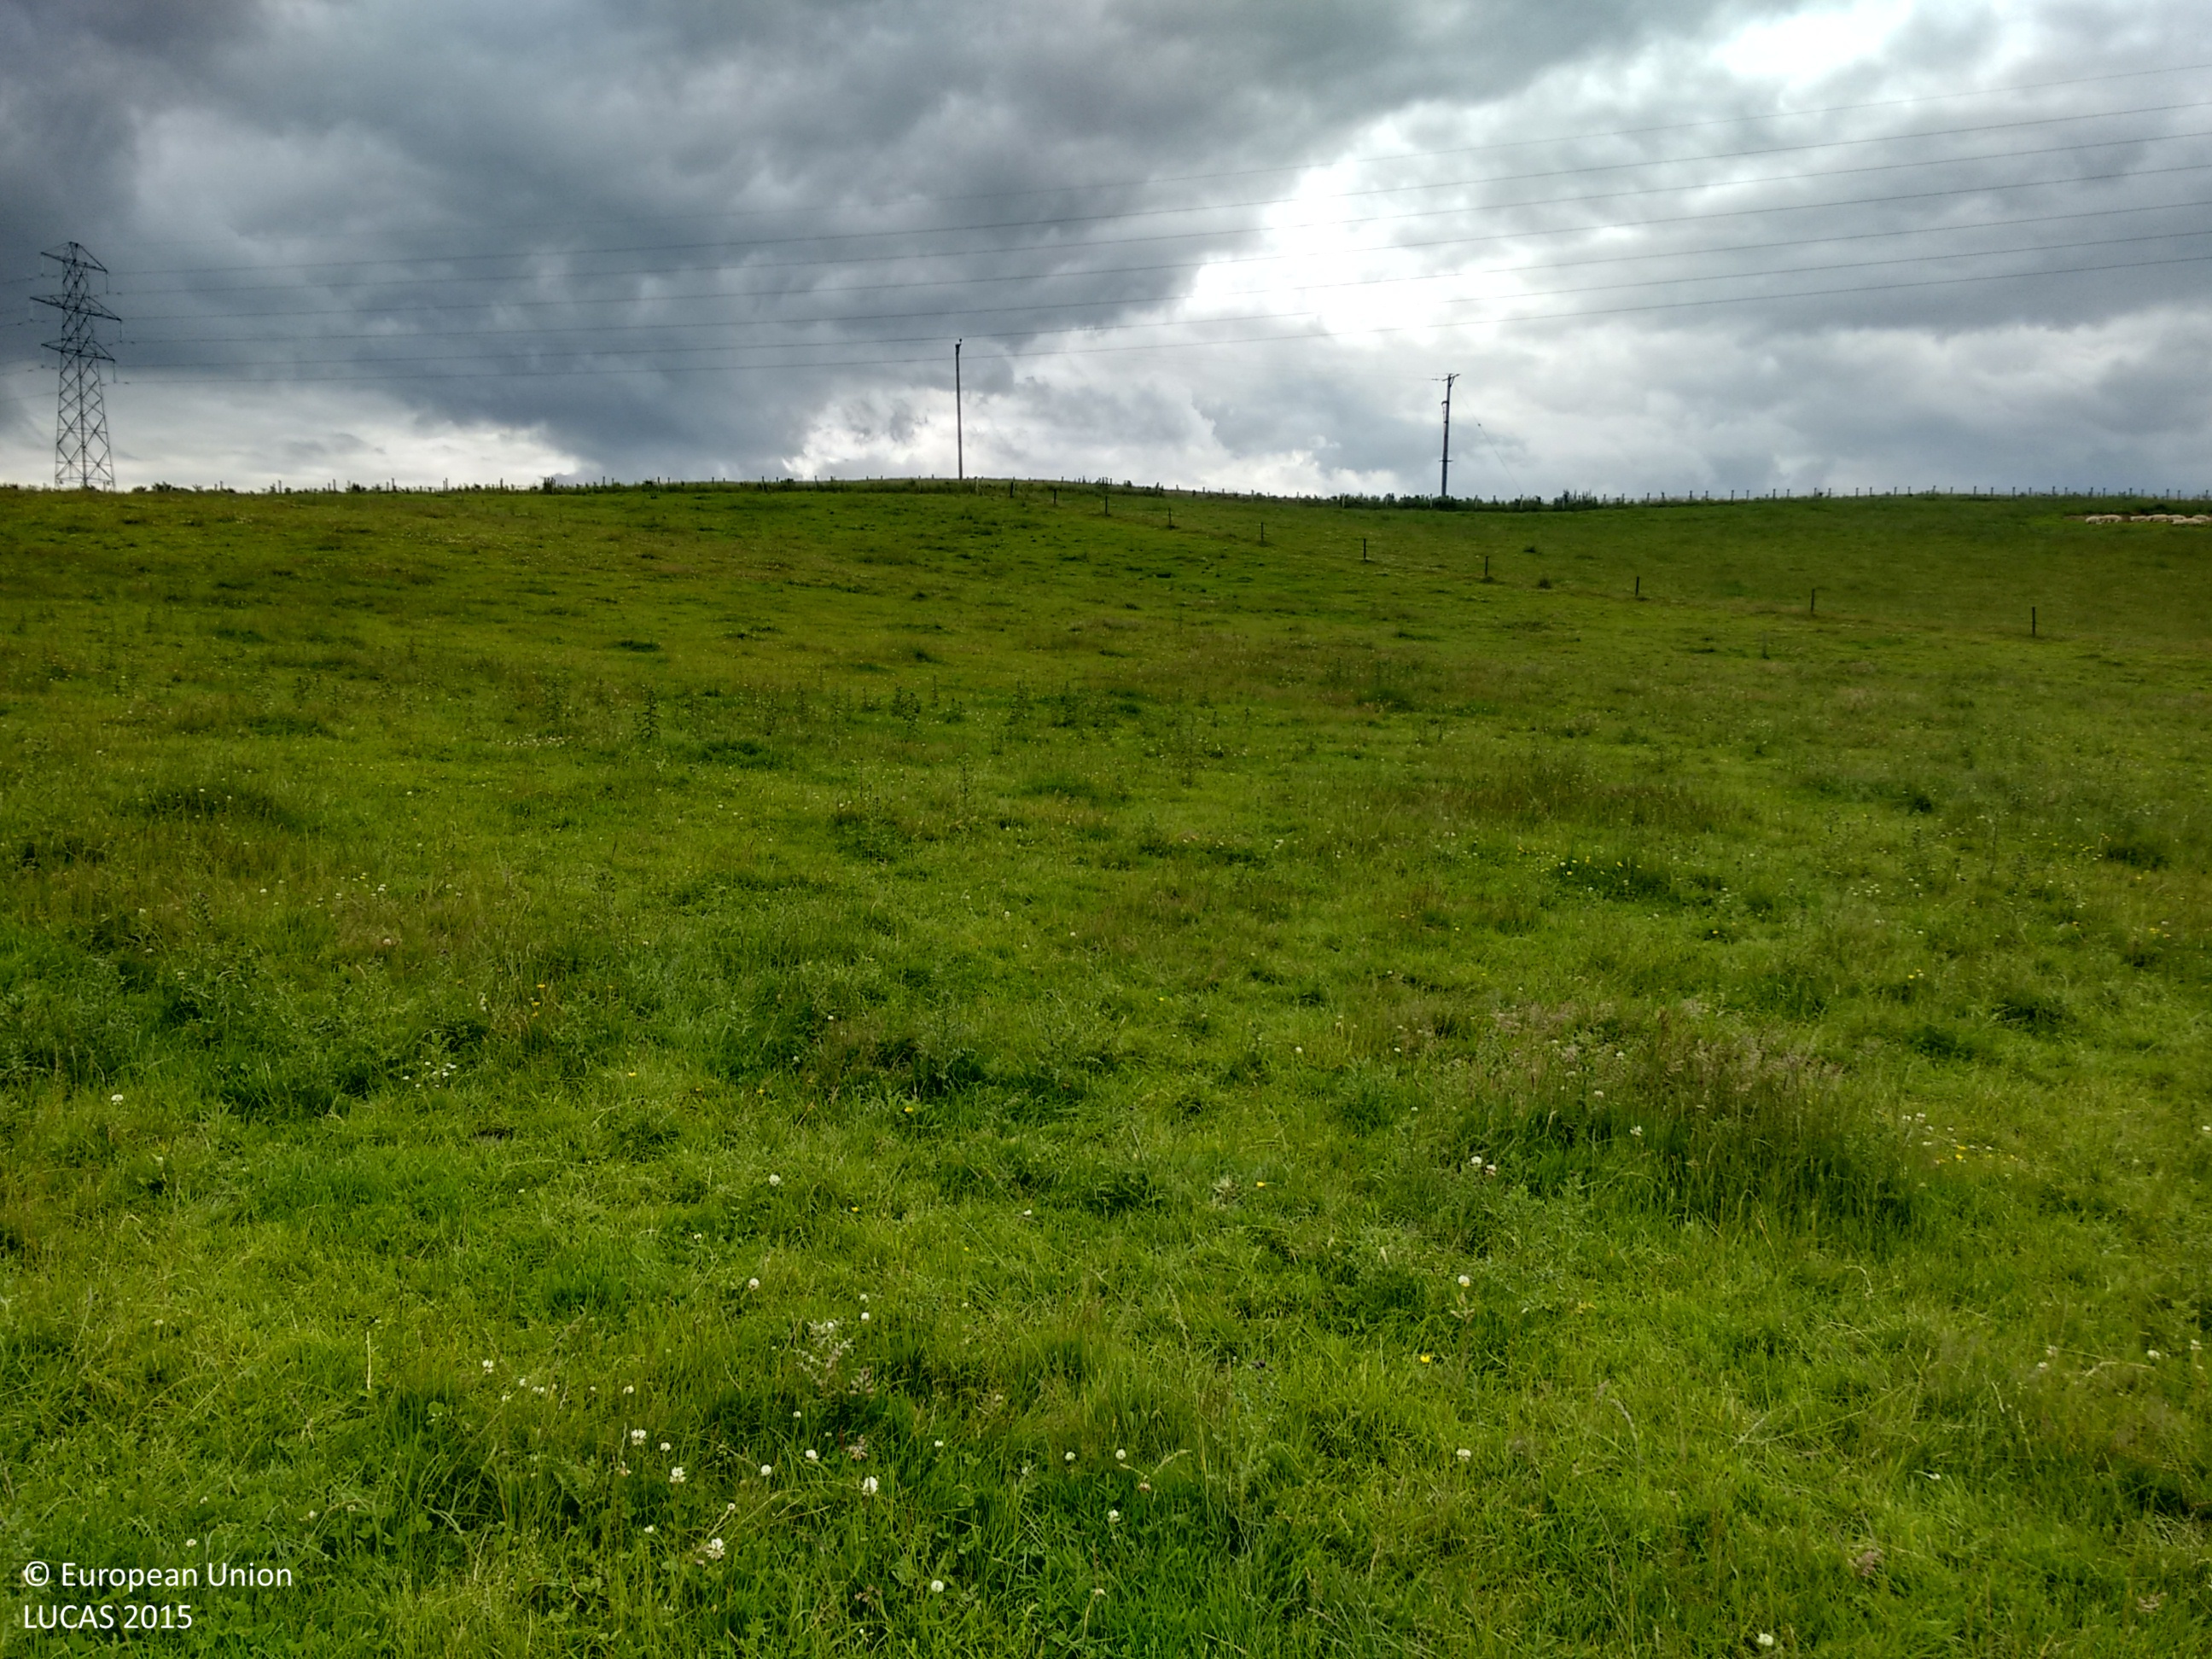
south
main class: Grassland
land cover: Grassland without tree/shrub cover
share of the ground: > 75 %
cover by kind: herbaceous plants 100 %
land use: Agriculture (excluding fallow land and kitchen gardens)
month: July
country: GB
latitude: 57.6441
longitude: -1.9893
